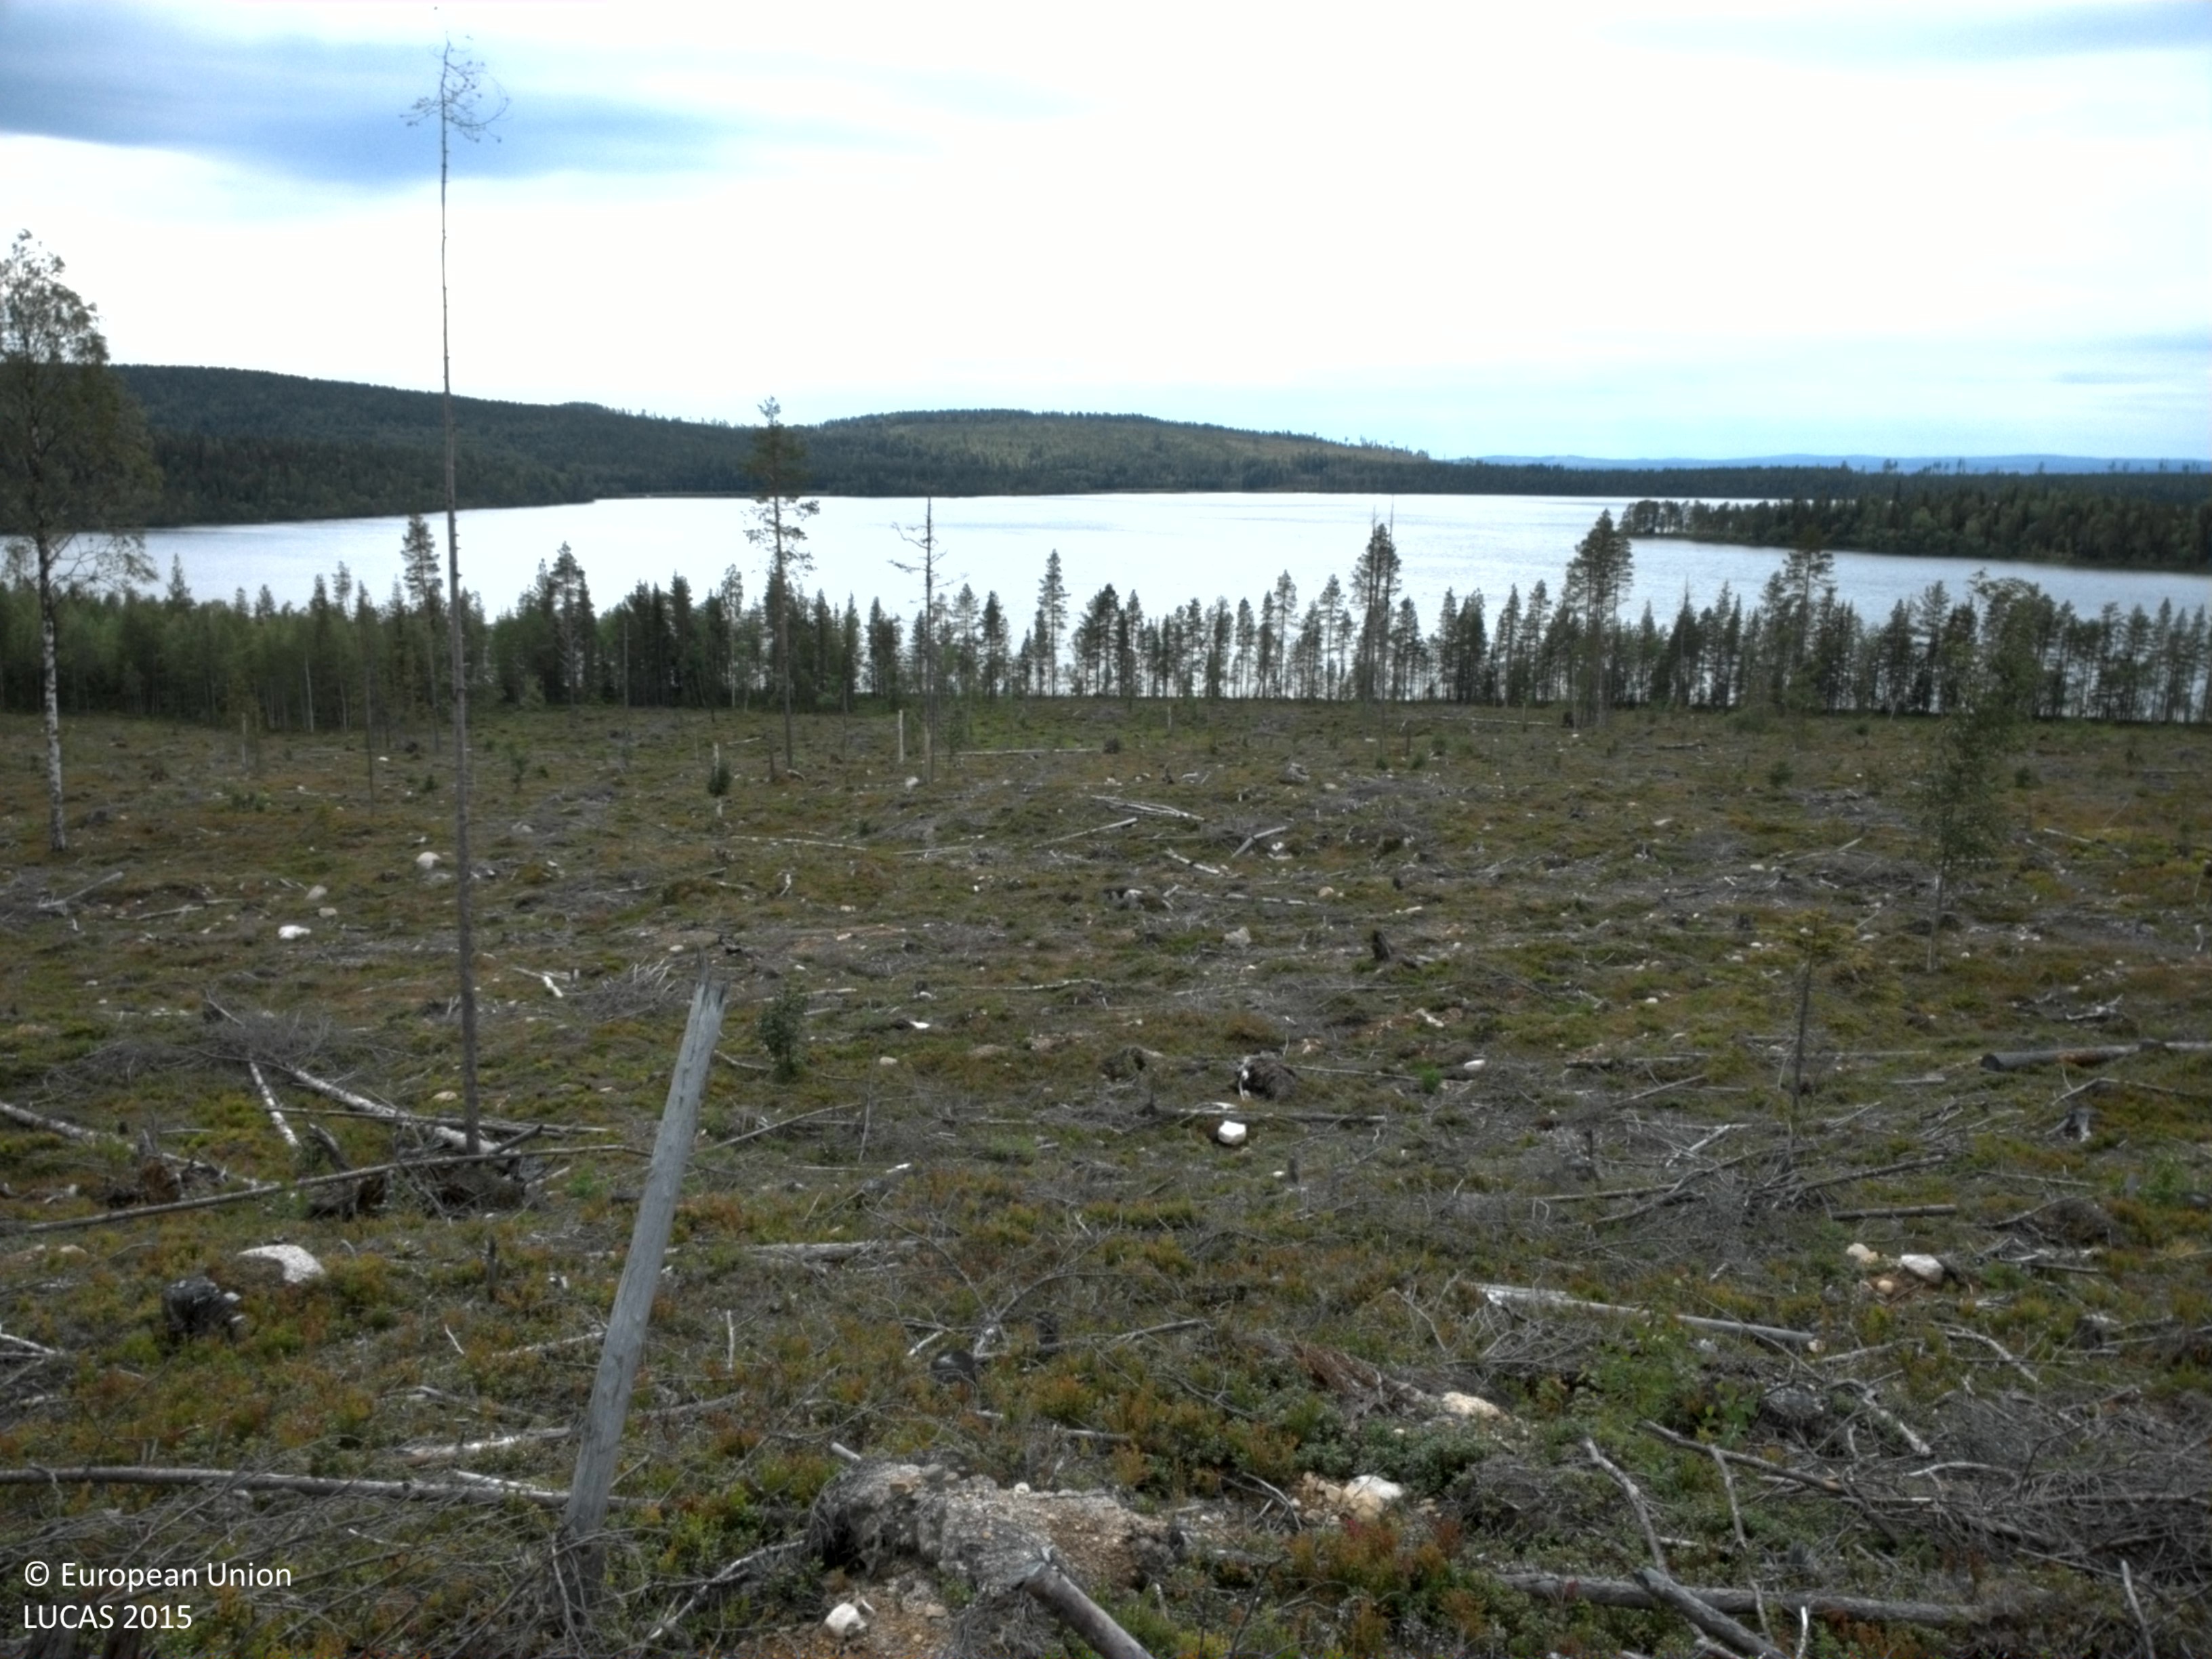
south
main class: Shrubland
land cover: Shrubland with sparse tree cover
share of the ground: > 75 %
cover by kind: shrubs 80 %, broadleaved forest trees 5 %, lichens and mosses 5 %, consolidated bare surface 5 %, unconsolidated bare surface 5 %
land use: Forestry
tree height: < 5 m
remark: Clear cut
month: August
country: SE
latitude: 66.3137
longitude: 20.5098
